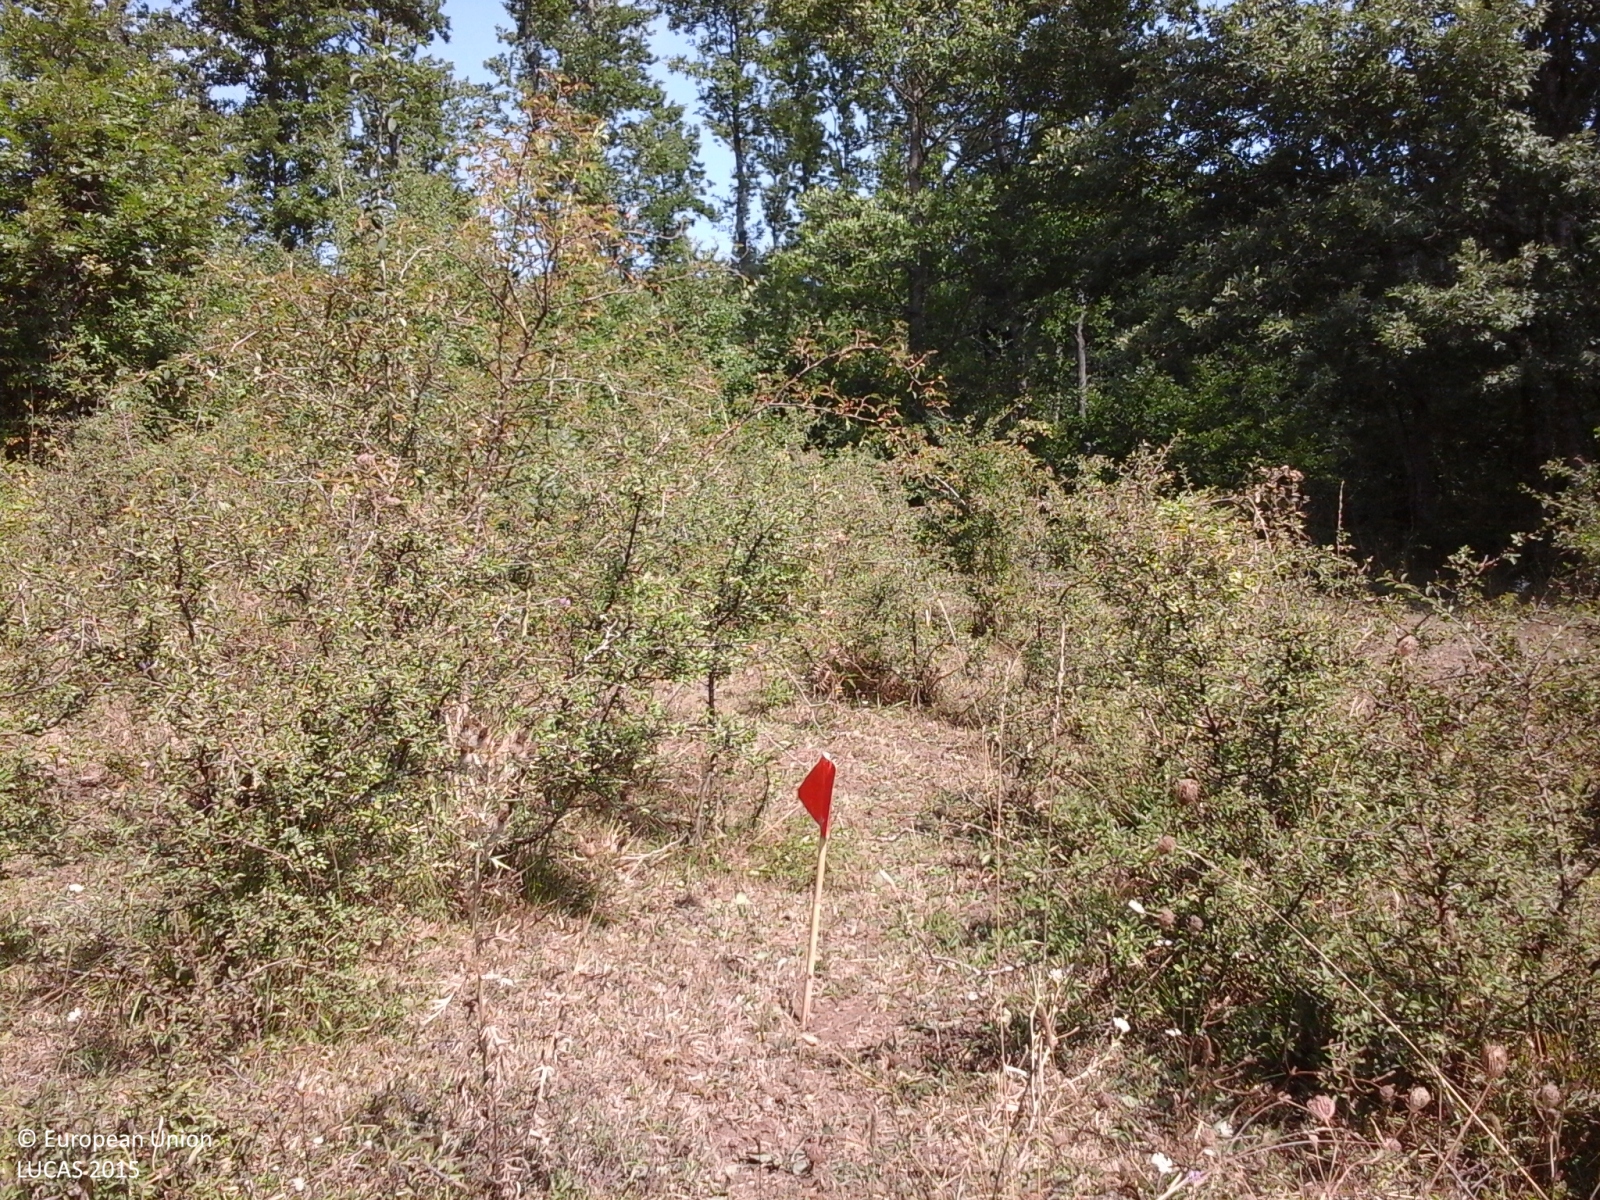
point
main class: Shrubland
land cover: Shrubland with sparse tree cover
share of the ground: > 75 %
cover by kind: herbaceous plants 50 %, shrubs 45 %, broadleaved forest trees 5 %
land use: Agriculture (excluding fallow land and kitchen gardens)
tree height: < 5 m
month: August
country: IT
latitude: 41.7666
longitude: 14.3036
